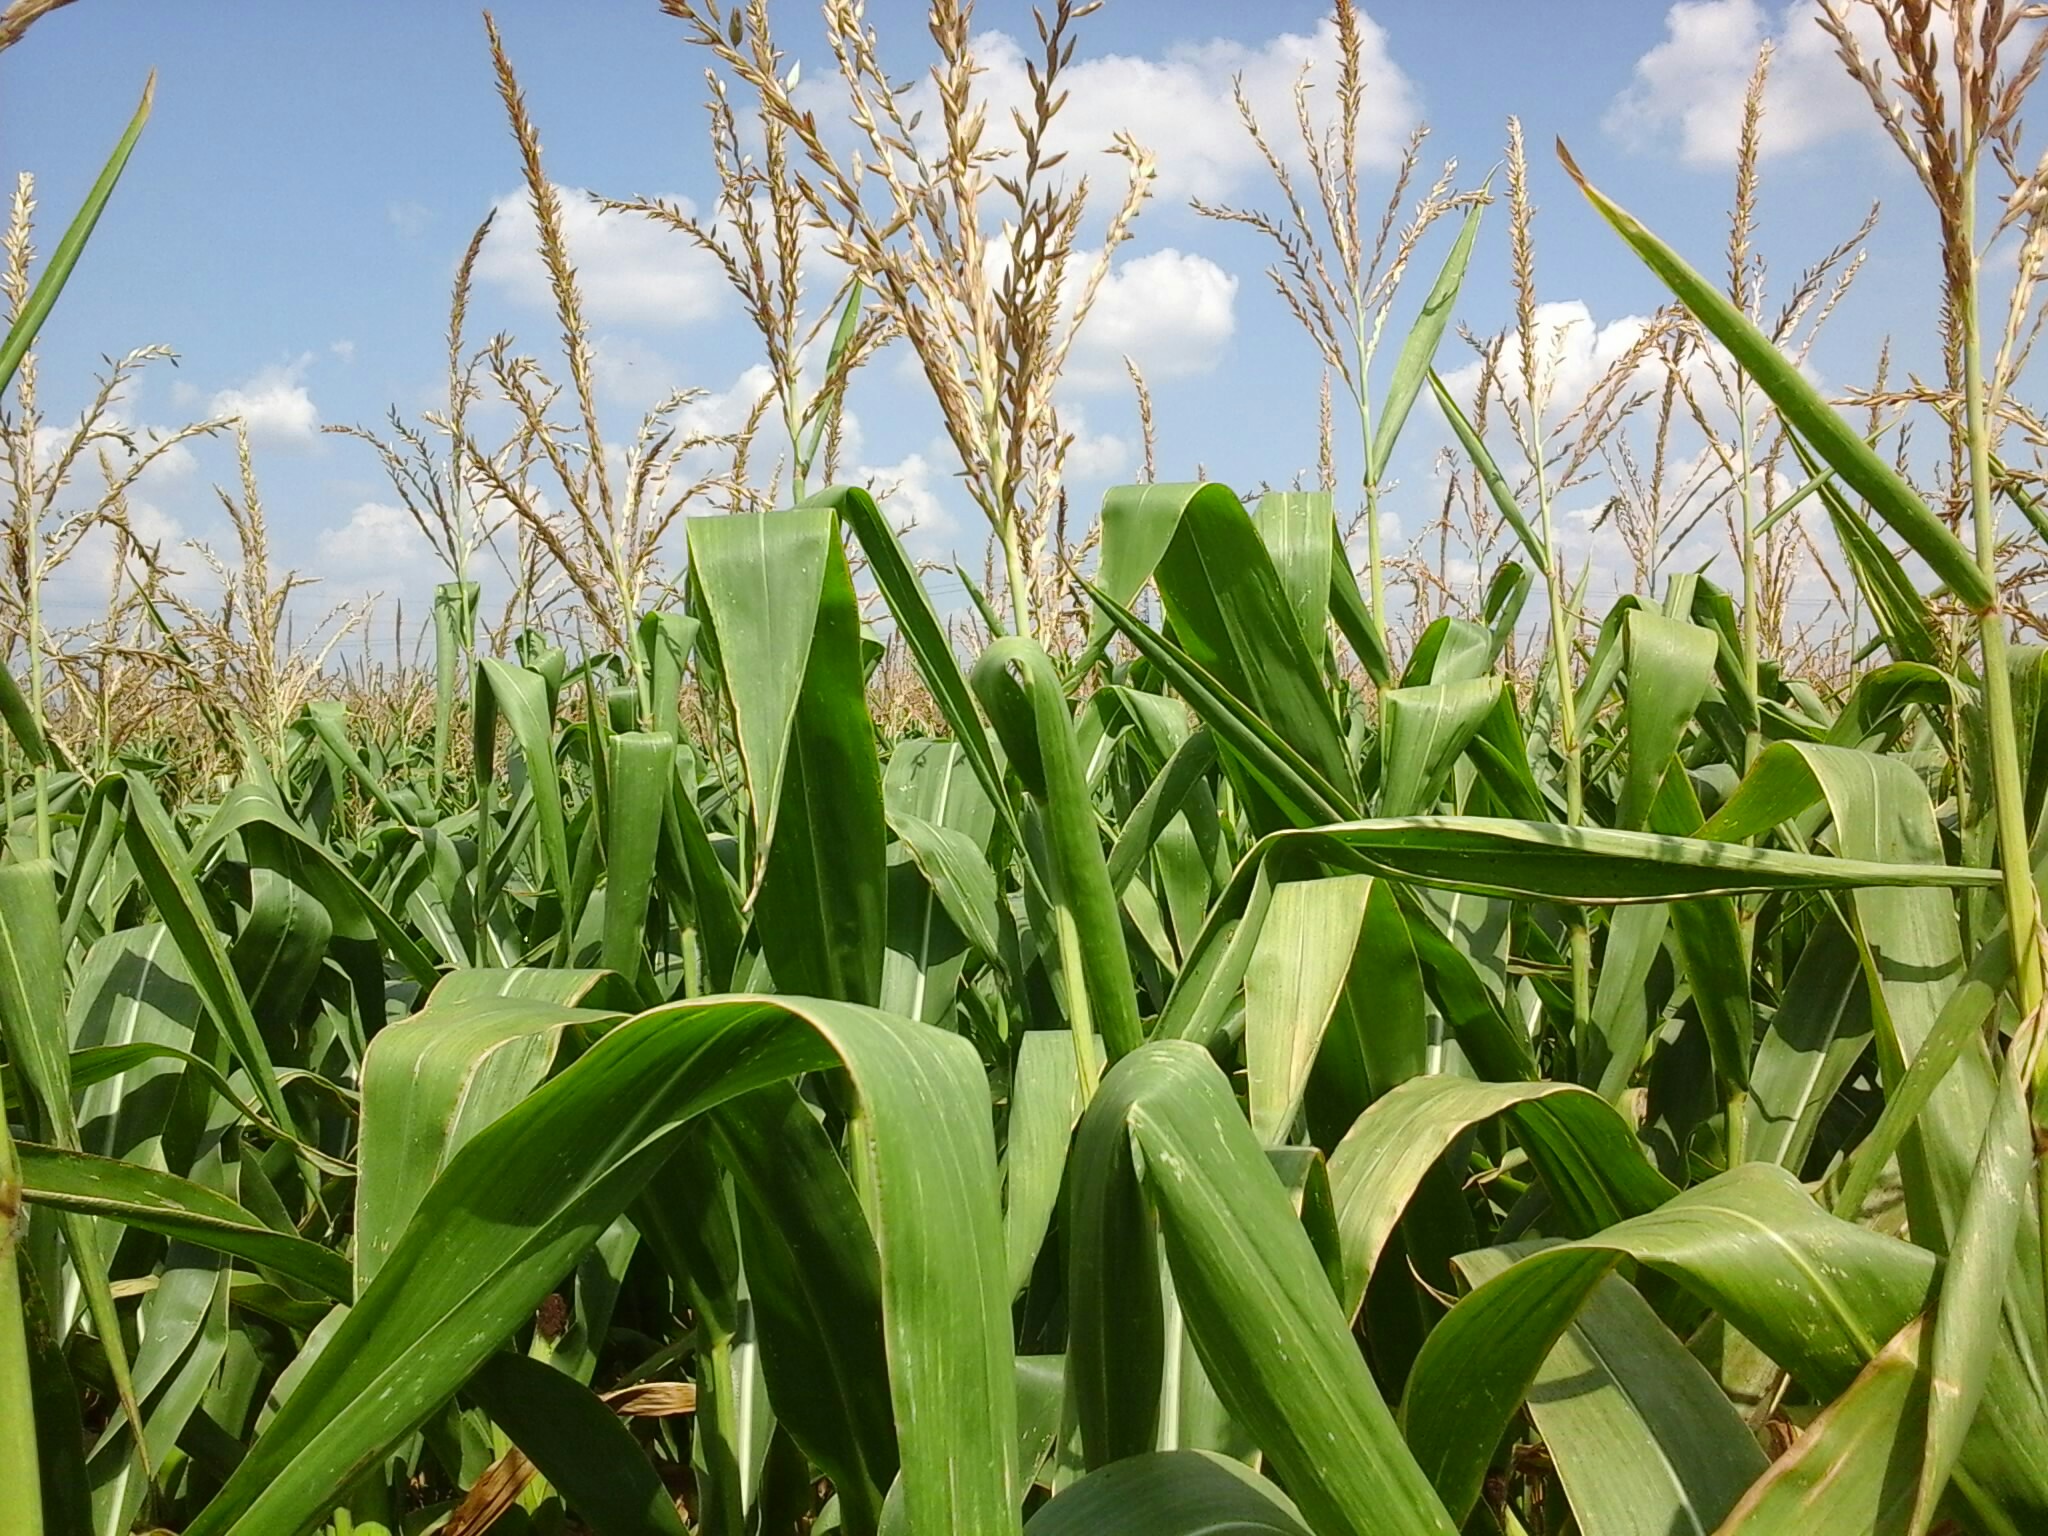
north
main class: Cropland
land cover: Maize
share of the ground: > 75 %
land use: Agriculture (excluding fallow land and kitchen gardens)
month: August
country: HU
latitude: 47.5689
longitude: 18.0265
